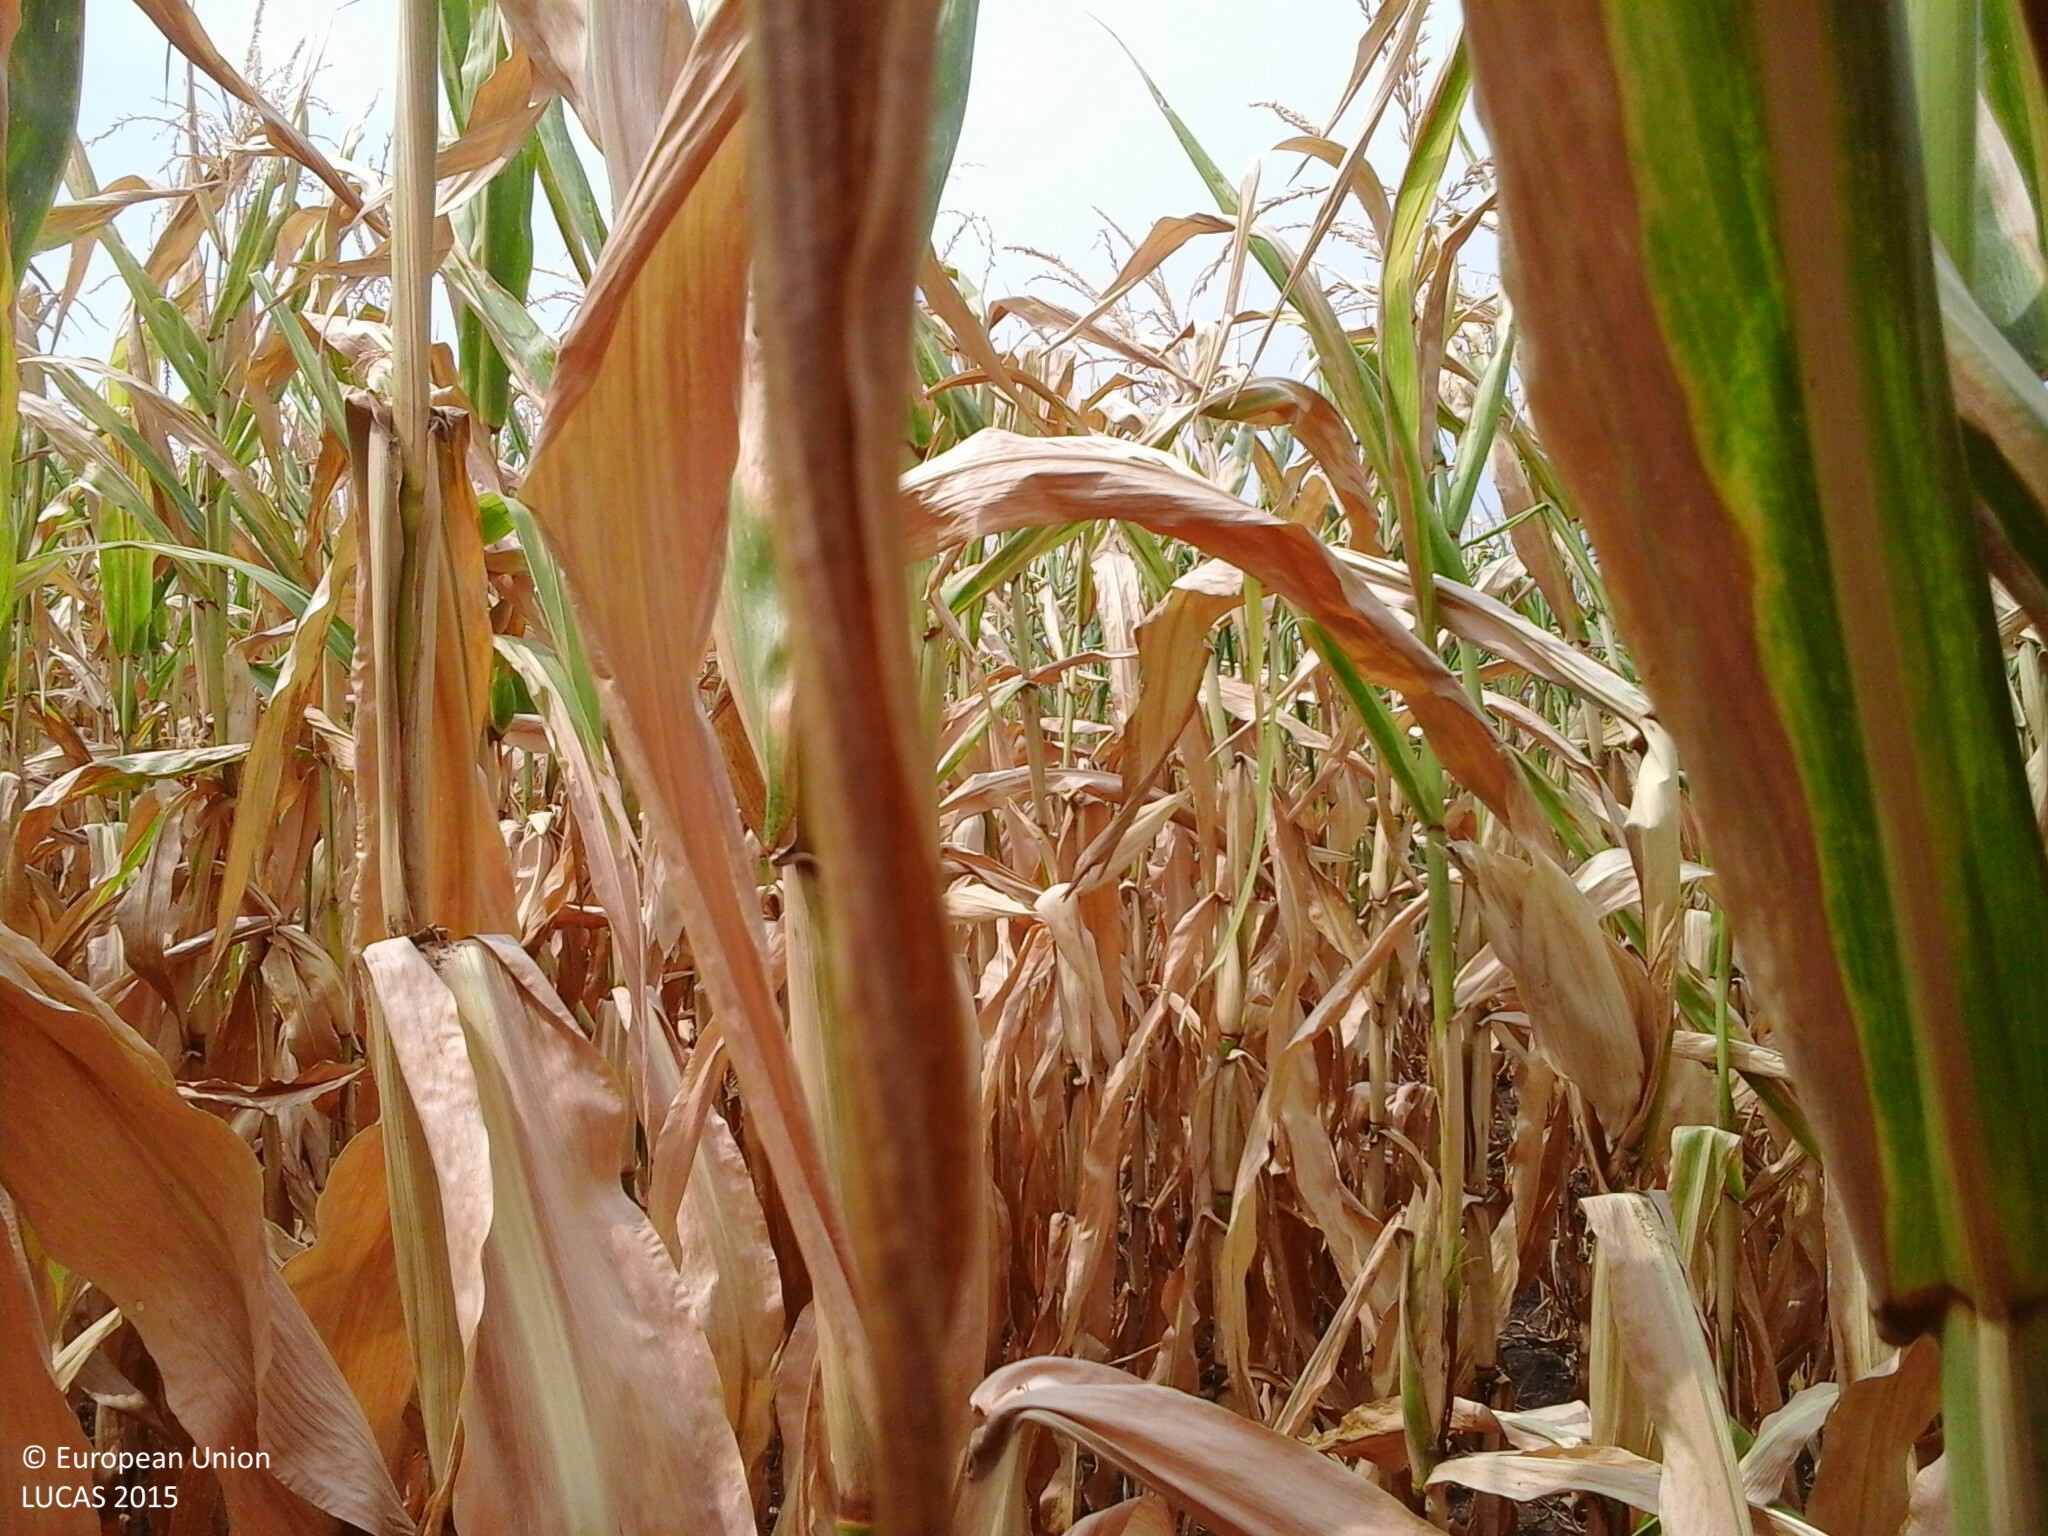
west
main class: Cropland
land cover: Maize
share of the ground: > 75 %
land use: Agriculture (excluding fallow land and kitchen gardens)
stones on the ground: < 10 %
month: August
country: HU
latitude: 47.7590
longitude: 20.2889
